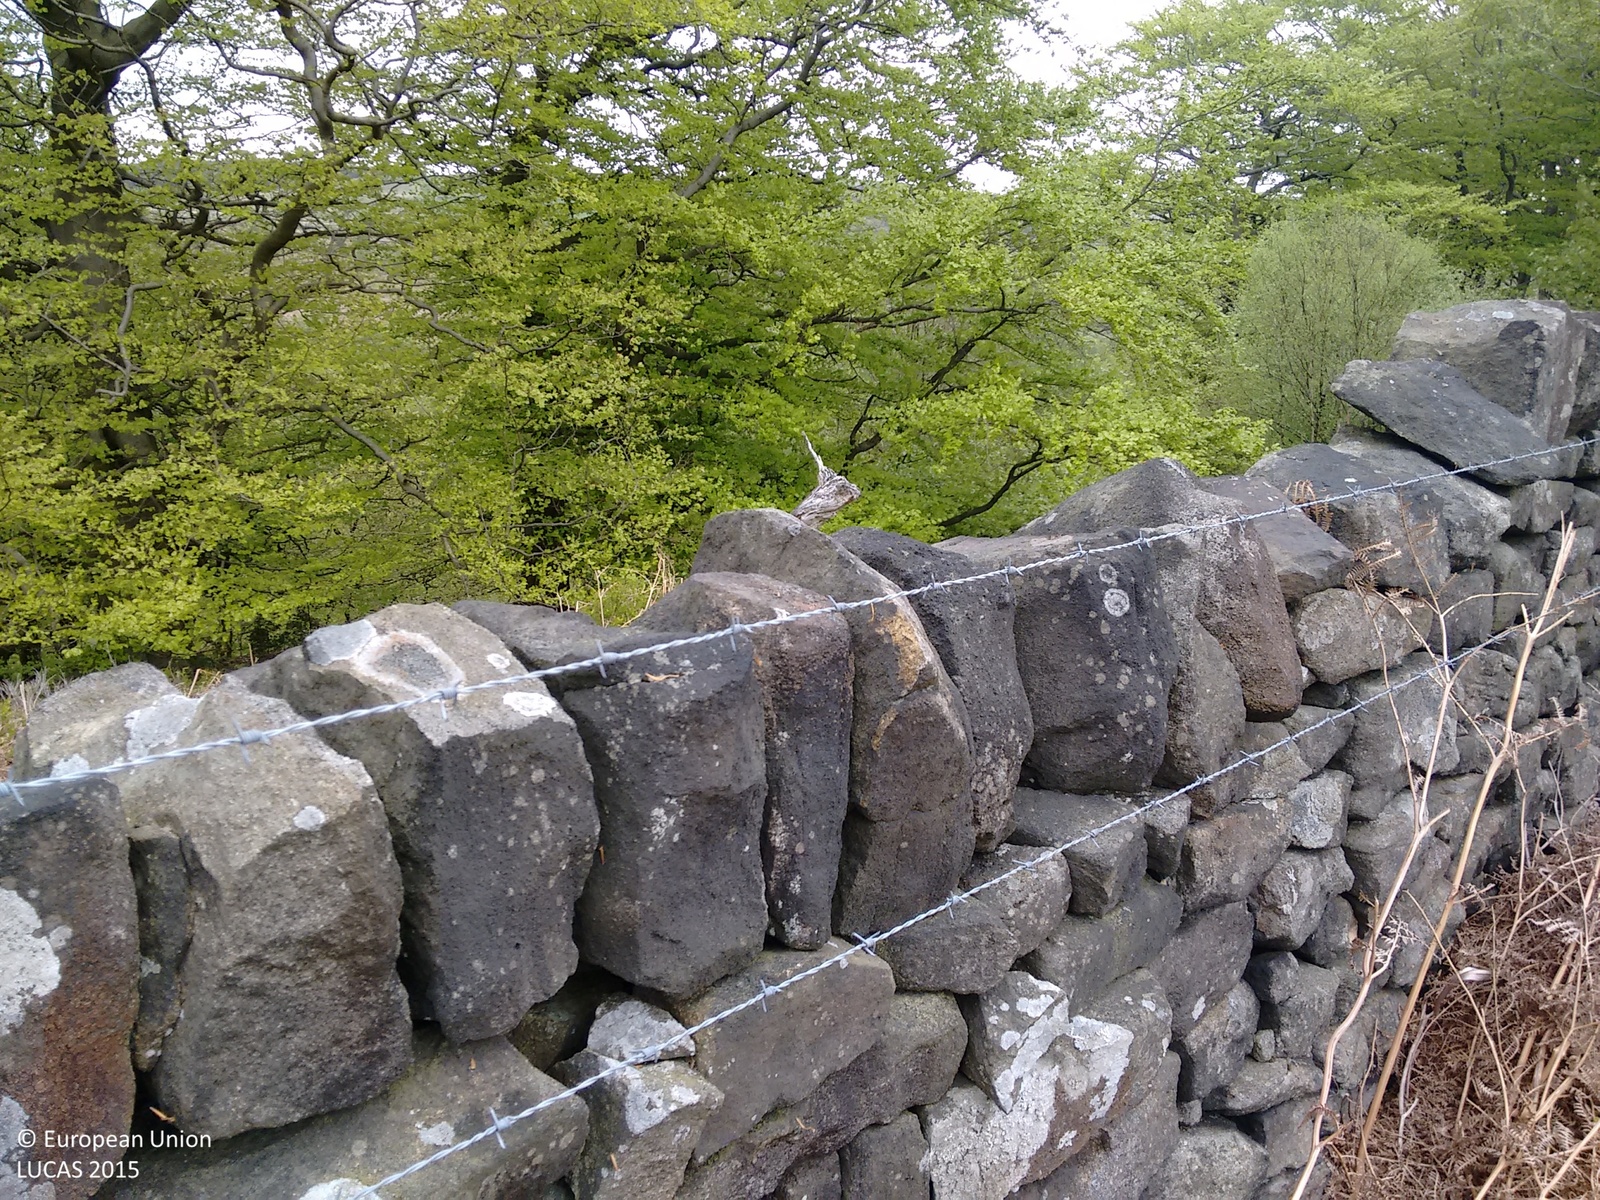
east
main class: Woodland
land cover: Broadleaved woodland
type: mesophytic deciduous forest
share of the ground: > 75 %
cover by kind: broadleaved forest trees 100 %
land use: Forestry
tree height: > 5 m
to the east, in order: Broadleaved woodland; Rivers and streams; Broadleaved woodland
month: May
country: GB
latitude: 53.4392
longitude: -1.6284
